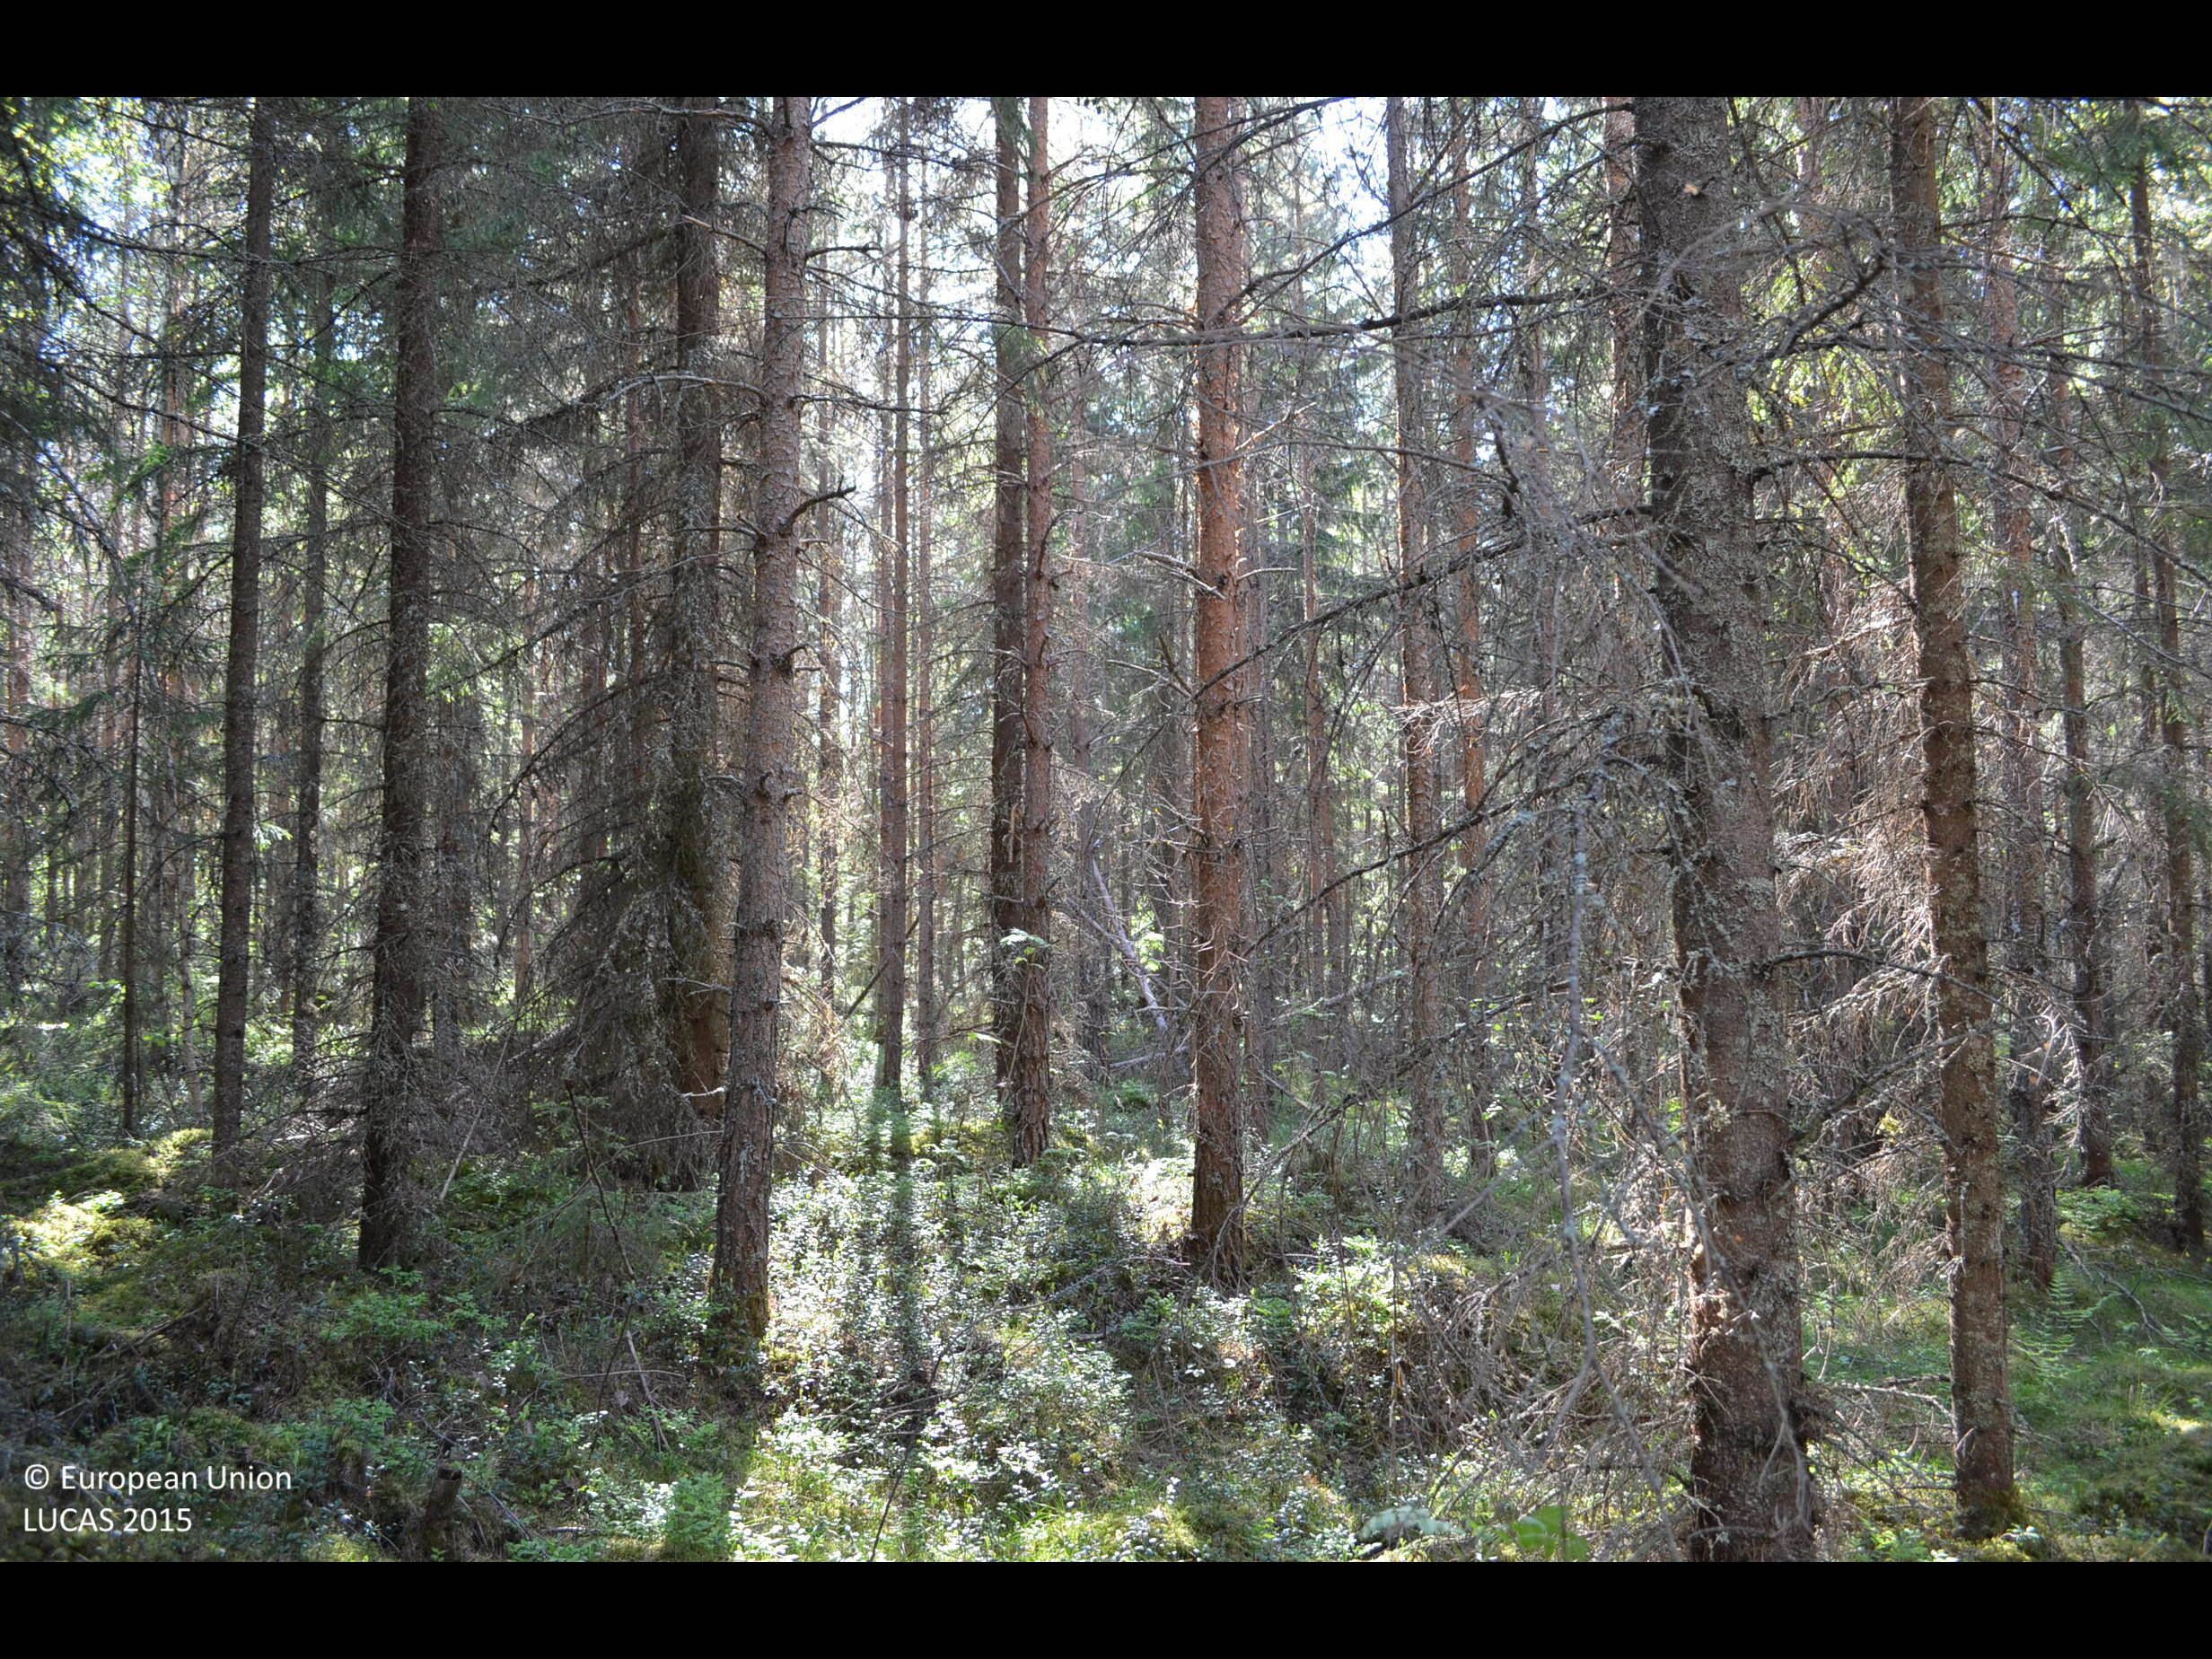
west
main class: Woodland
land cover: Pine dominated coniferous woodland
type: boreal forest
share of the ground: > 75 %
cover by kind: coniferous forest trees 80 %, shrubs 15 %, broadleaved forest trees 5 %
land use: Forestry
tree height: > 5 m
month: June
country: FI
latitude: 61.9121
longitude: 23.2661
